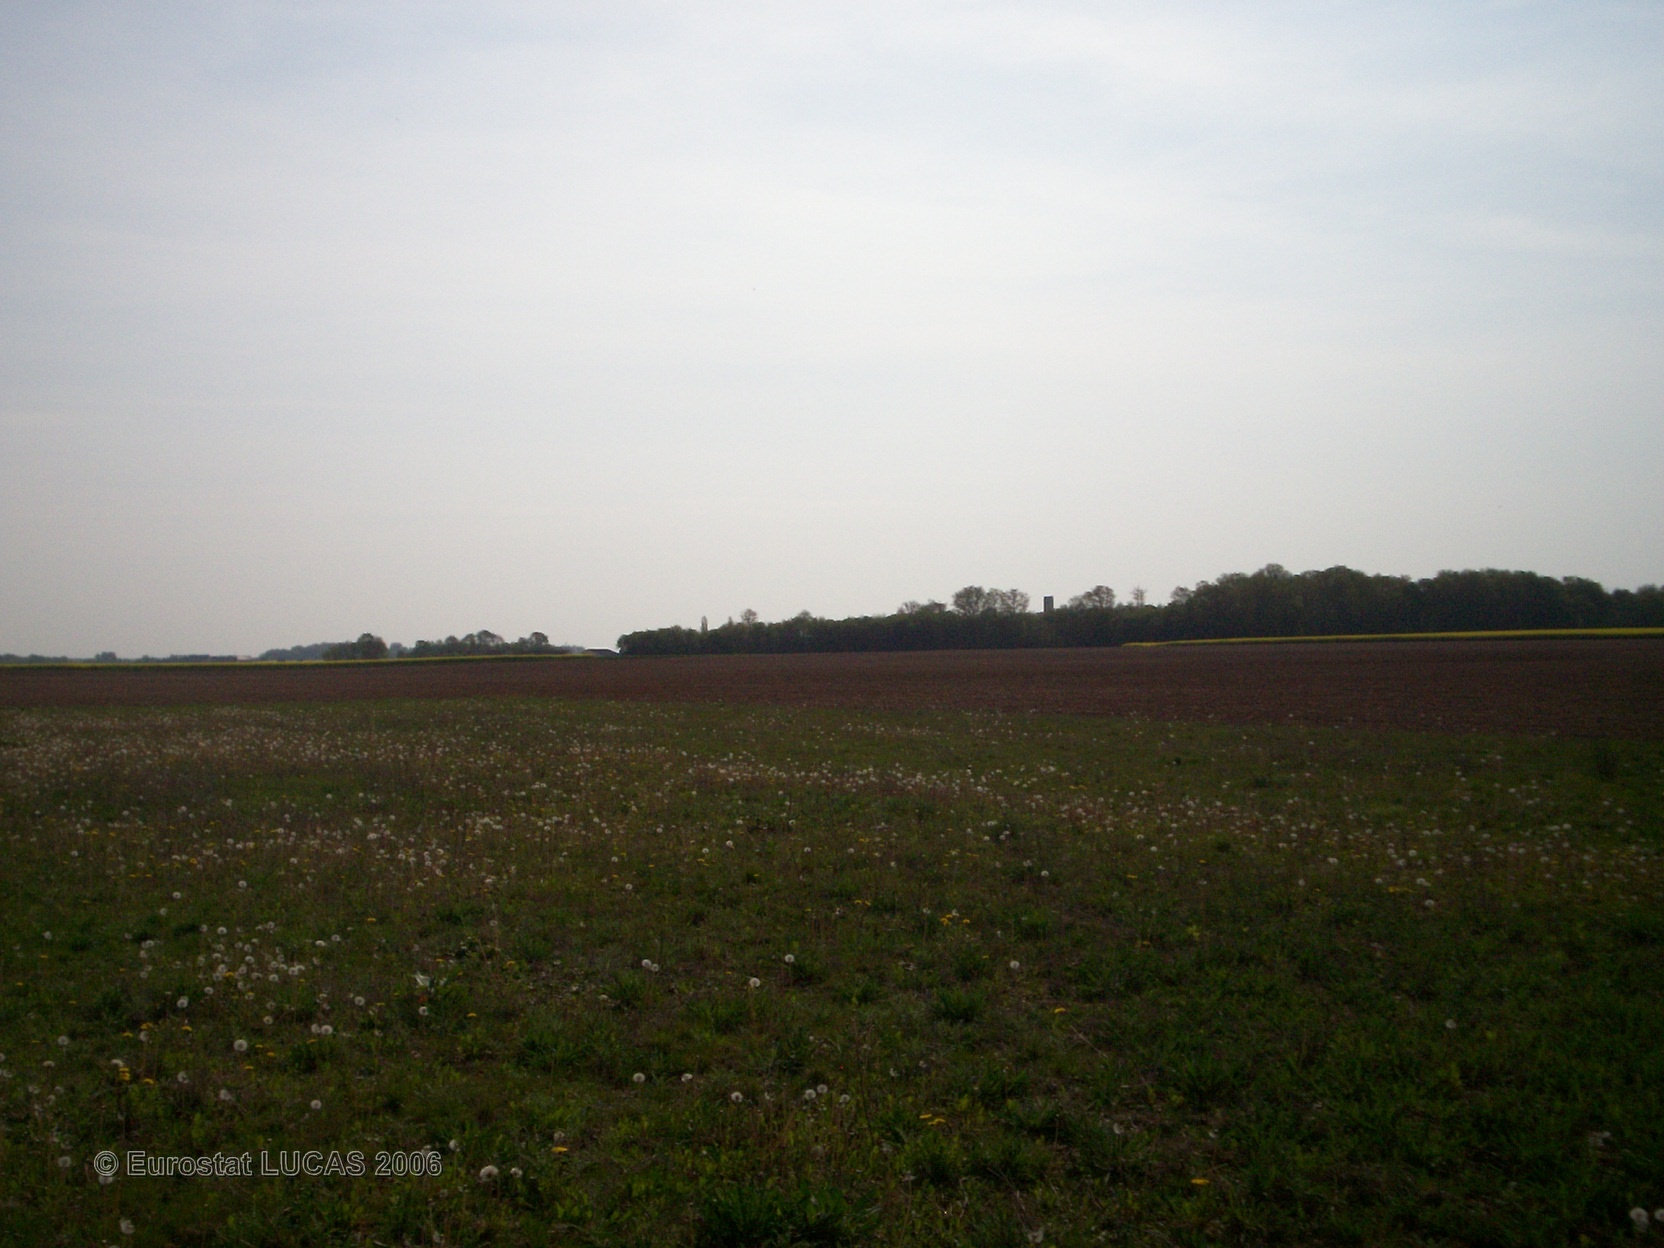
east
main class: Grassland
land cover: Grassland without tree/shrub cover
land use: Fallow land
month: May
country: FR
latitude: 48.0842
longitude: 2.8907
